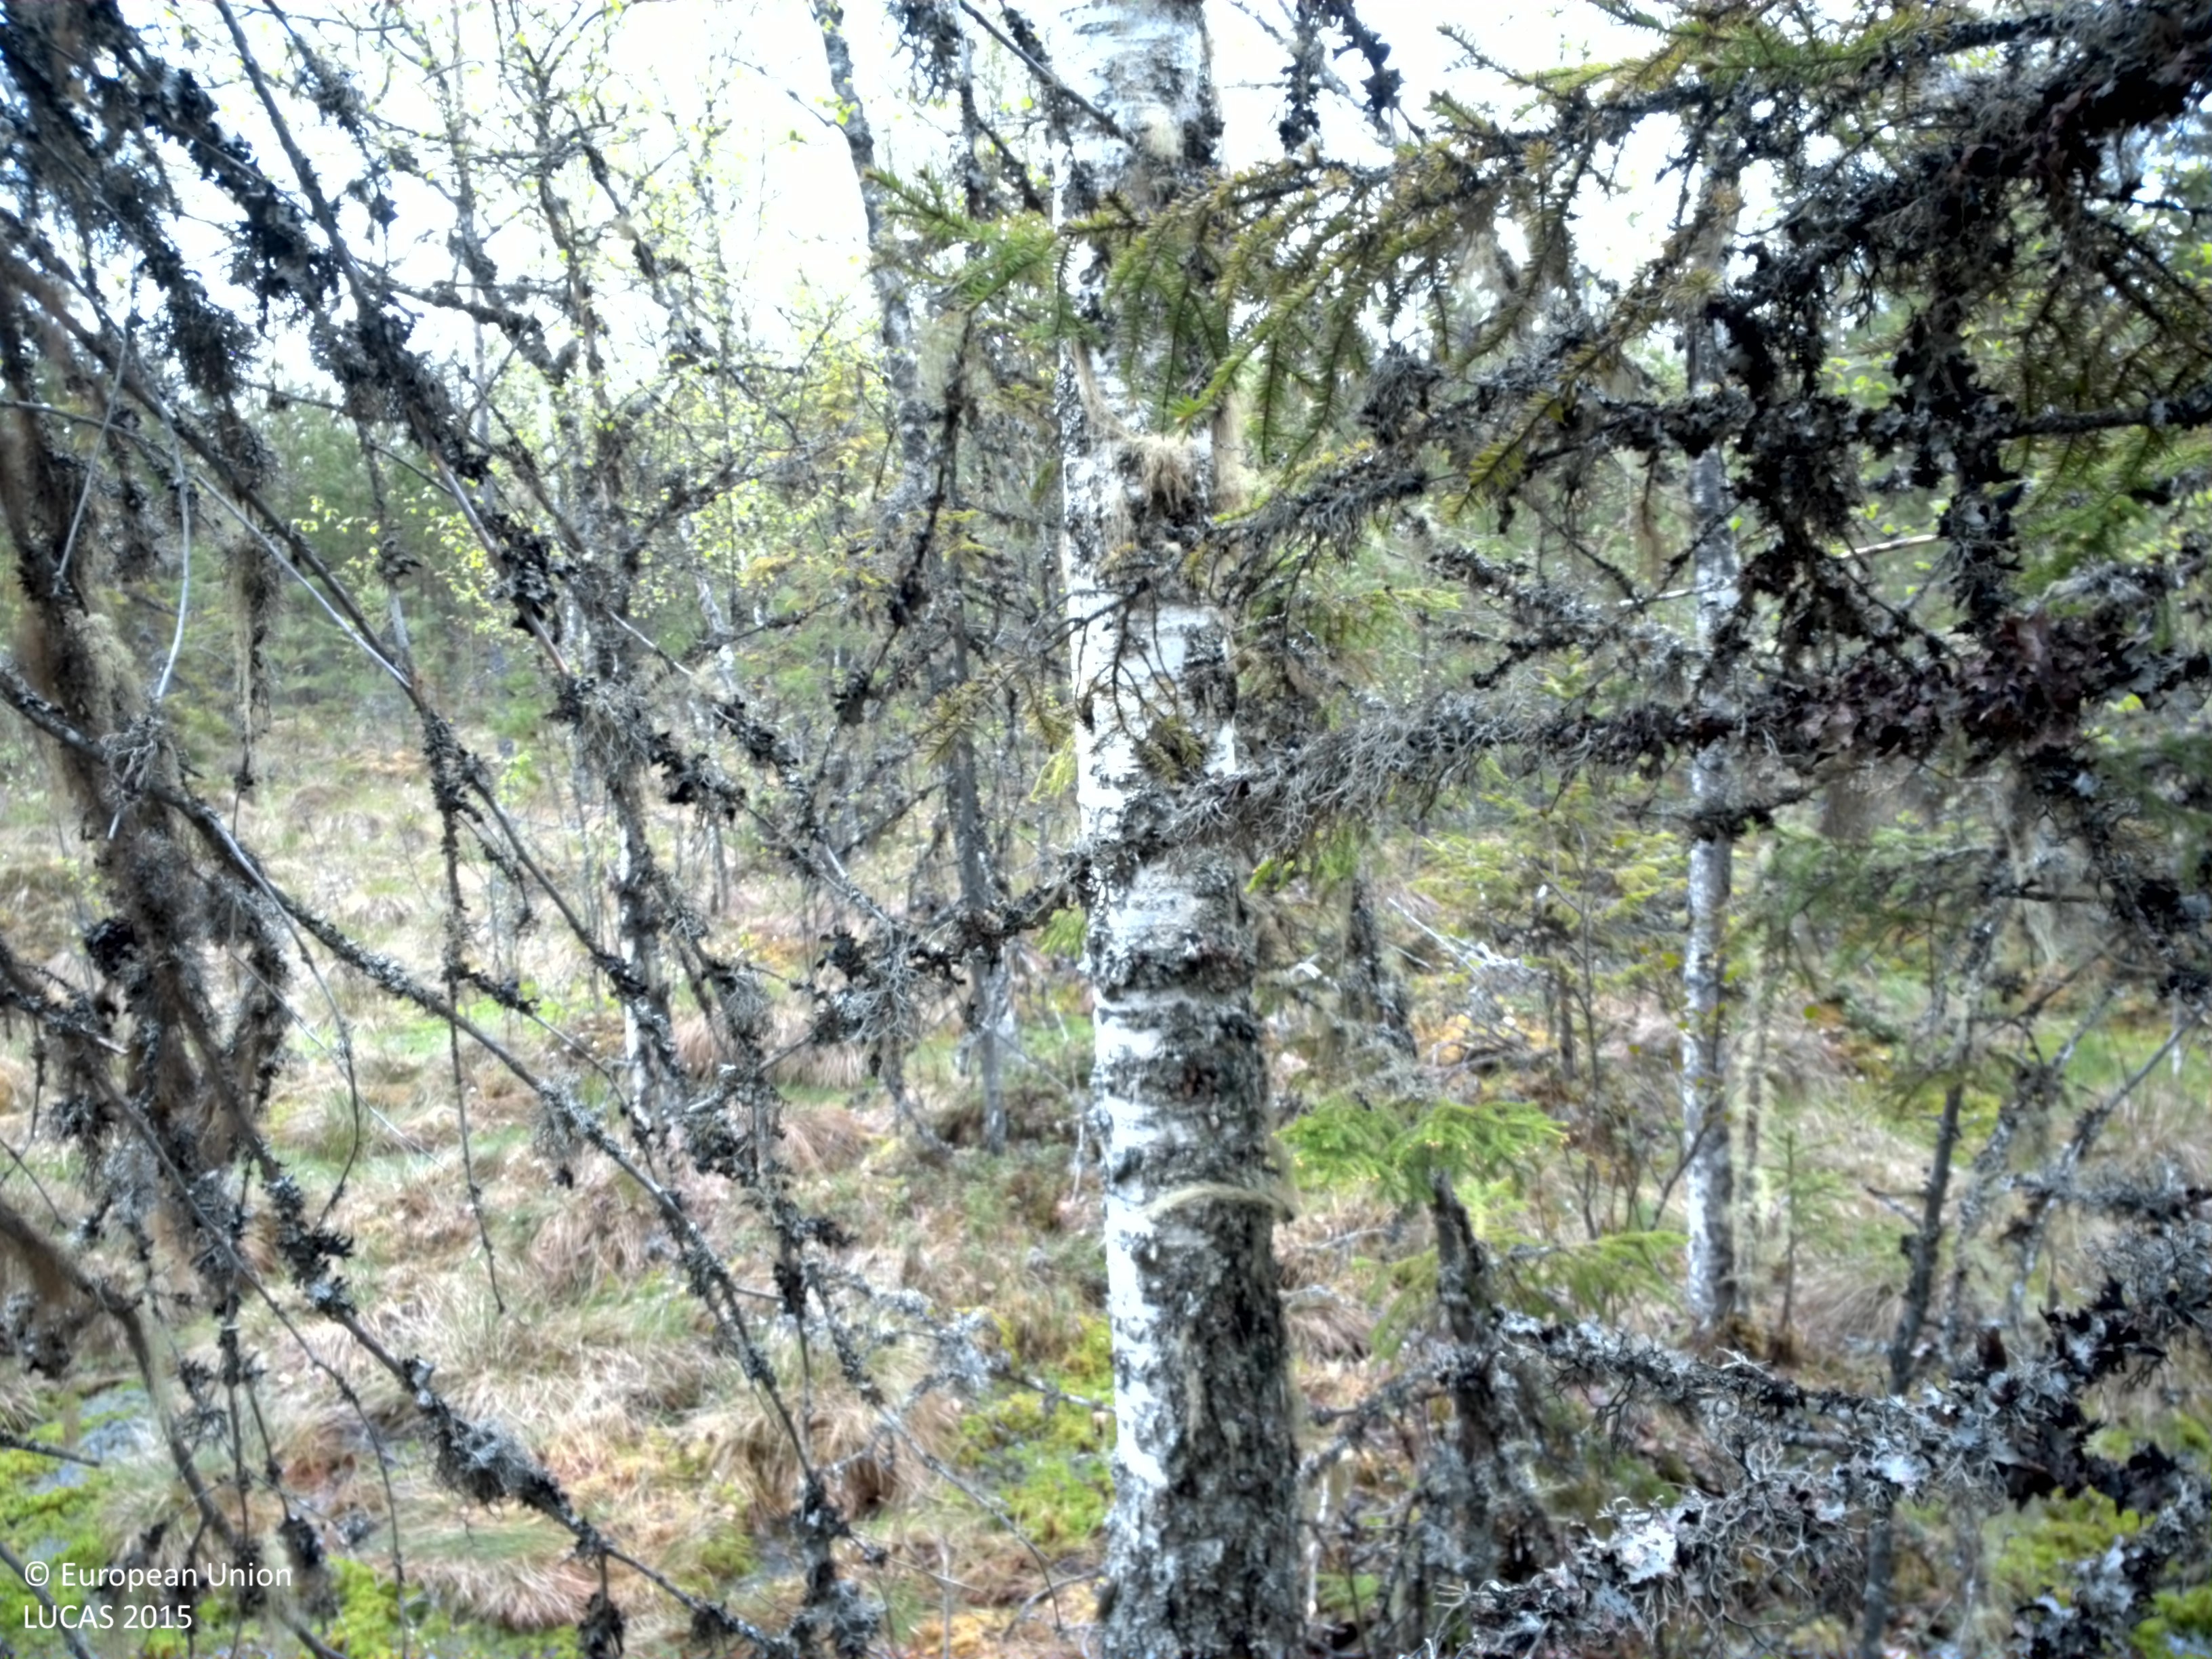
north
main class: Woodland
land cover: Pine dominated mixed woodland
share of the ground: 50 - 75 %
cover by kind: coniferous forest trees 30 %, broadleaved forest trees 30 %, shrubs 15 %, lichens and mosses 15 %, herbaceous plants 10 %
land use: Semi-natural and natural areas not in use
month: May
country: SE
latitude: 60.1832
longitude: 13.0744
